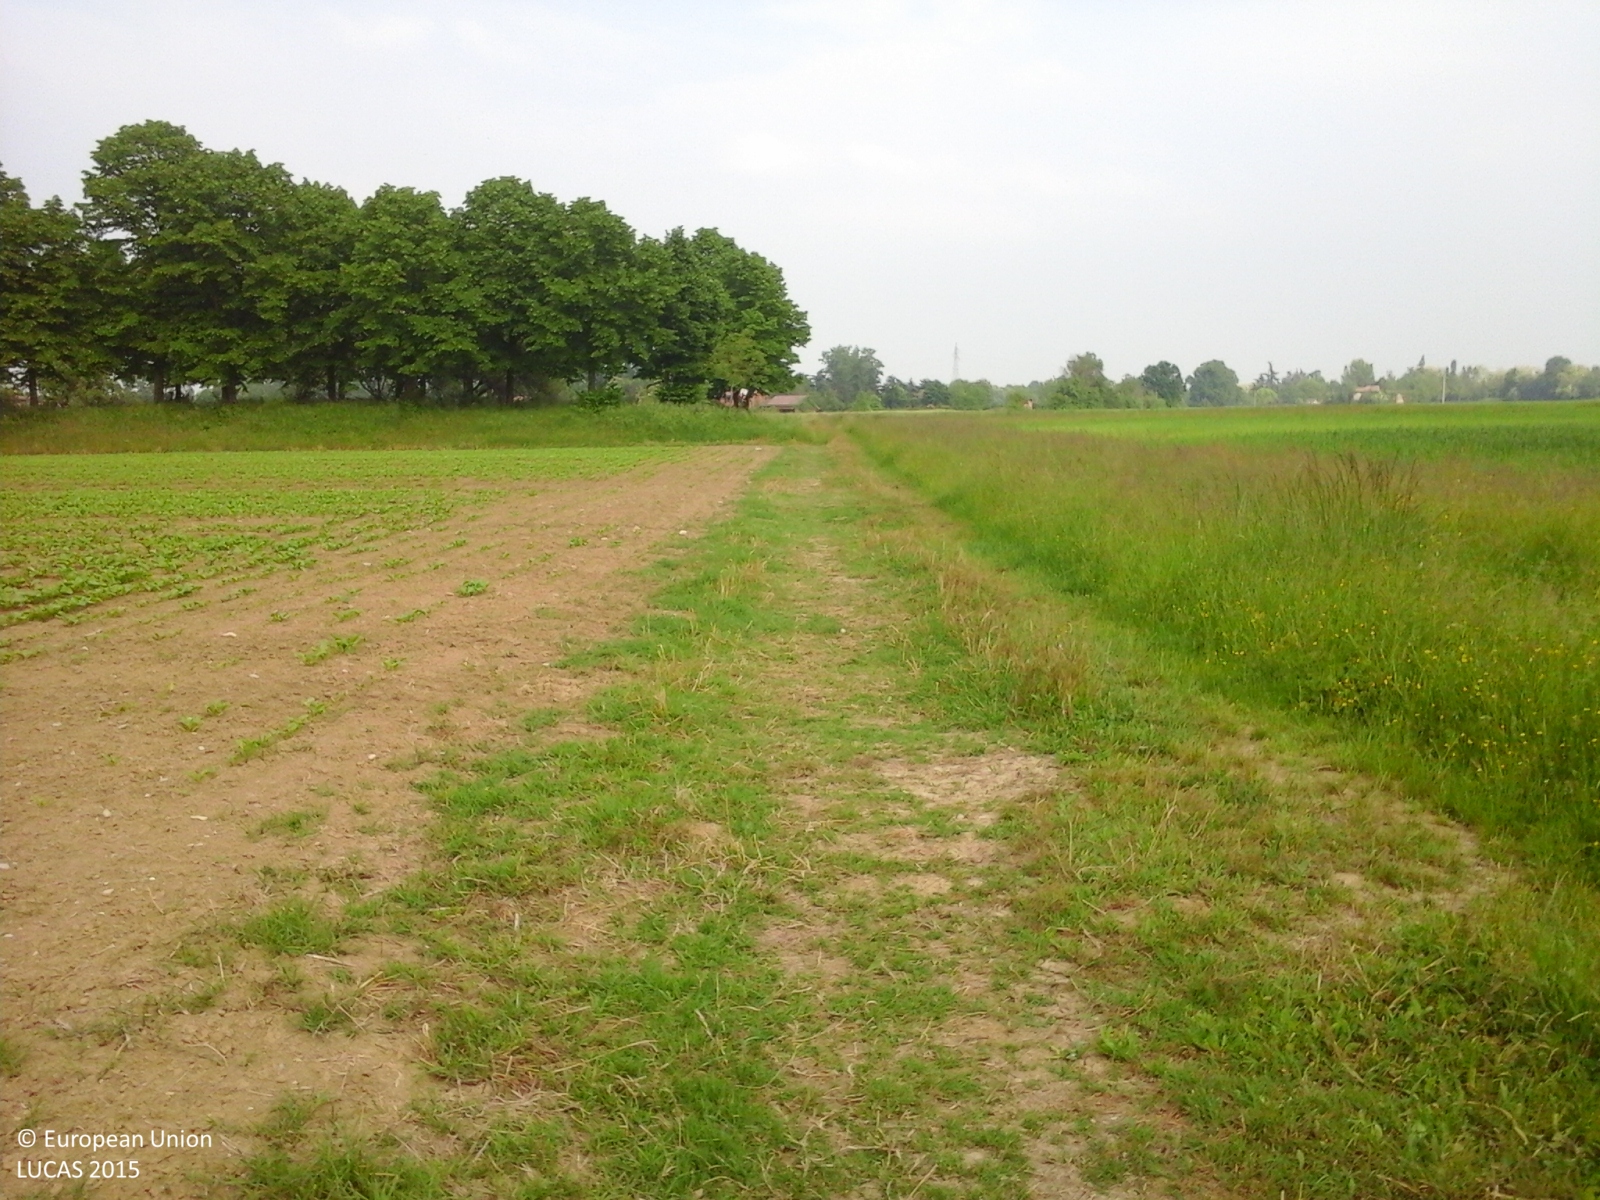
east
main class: Cropland
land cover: Sugar beet
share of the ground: 10 - 25 %
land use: Agriculture (excluding fallow land and kitchen gardens)
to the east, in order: Grass margins; Sugar beet; Grass margins; Sugar beet; Paved roads, cycling and walking lanes; Broadleaved woodland; Inland fresh water bodies; Broadleaved woodland; Grassland without tree/shrub cover; Ditches and canals; Sugar beet; Ditches and canals; Sugar beet; Ditches and canals; Sugar beet; Ditches and canals; Sugar beet
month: May
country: IT
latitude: 44.5629
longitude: 10.9171
